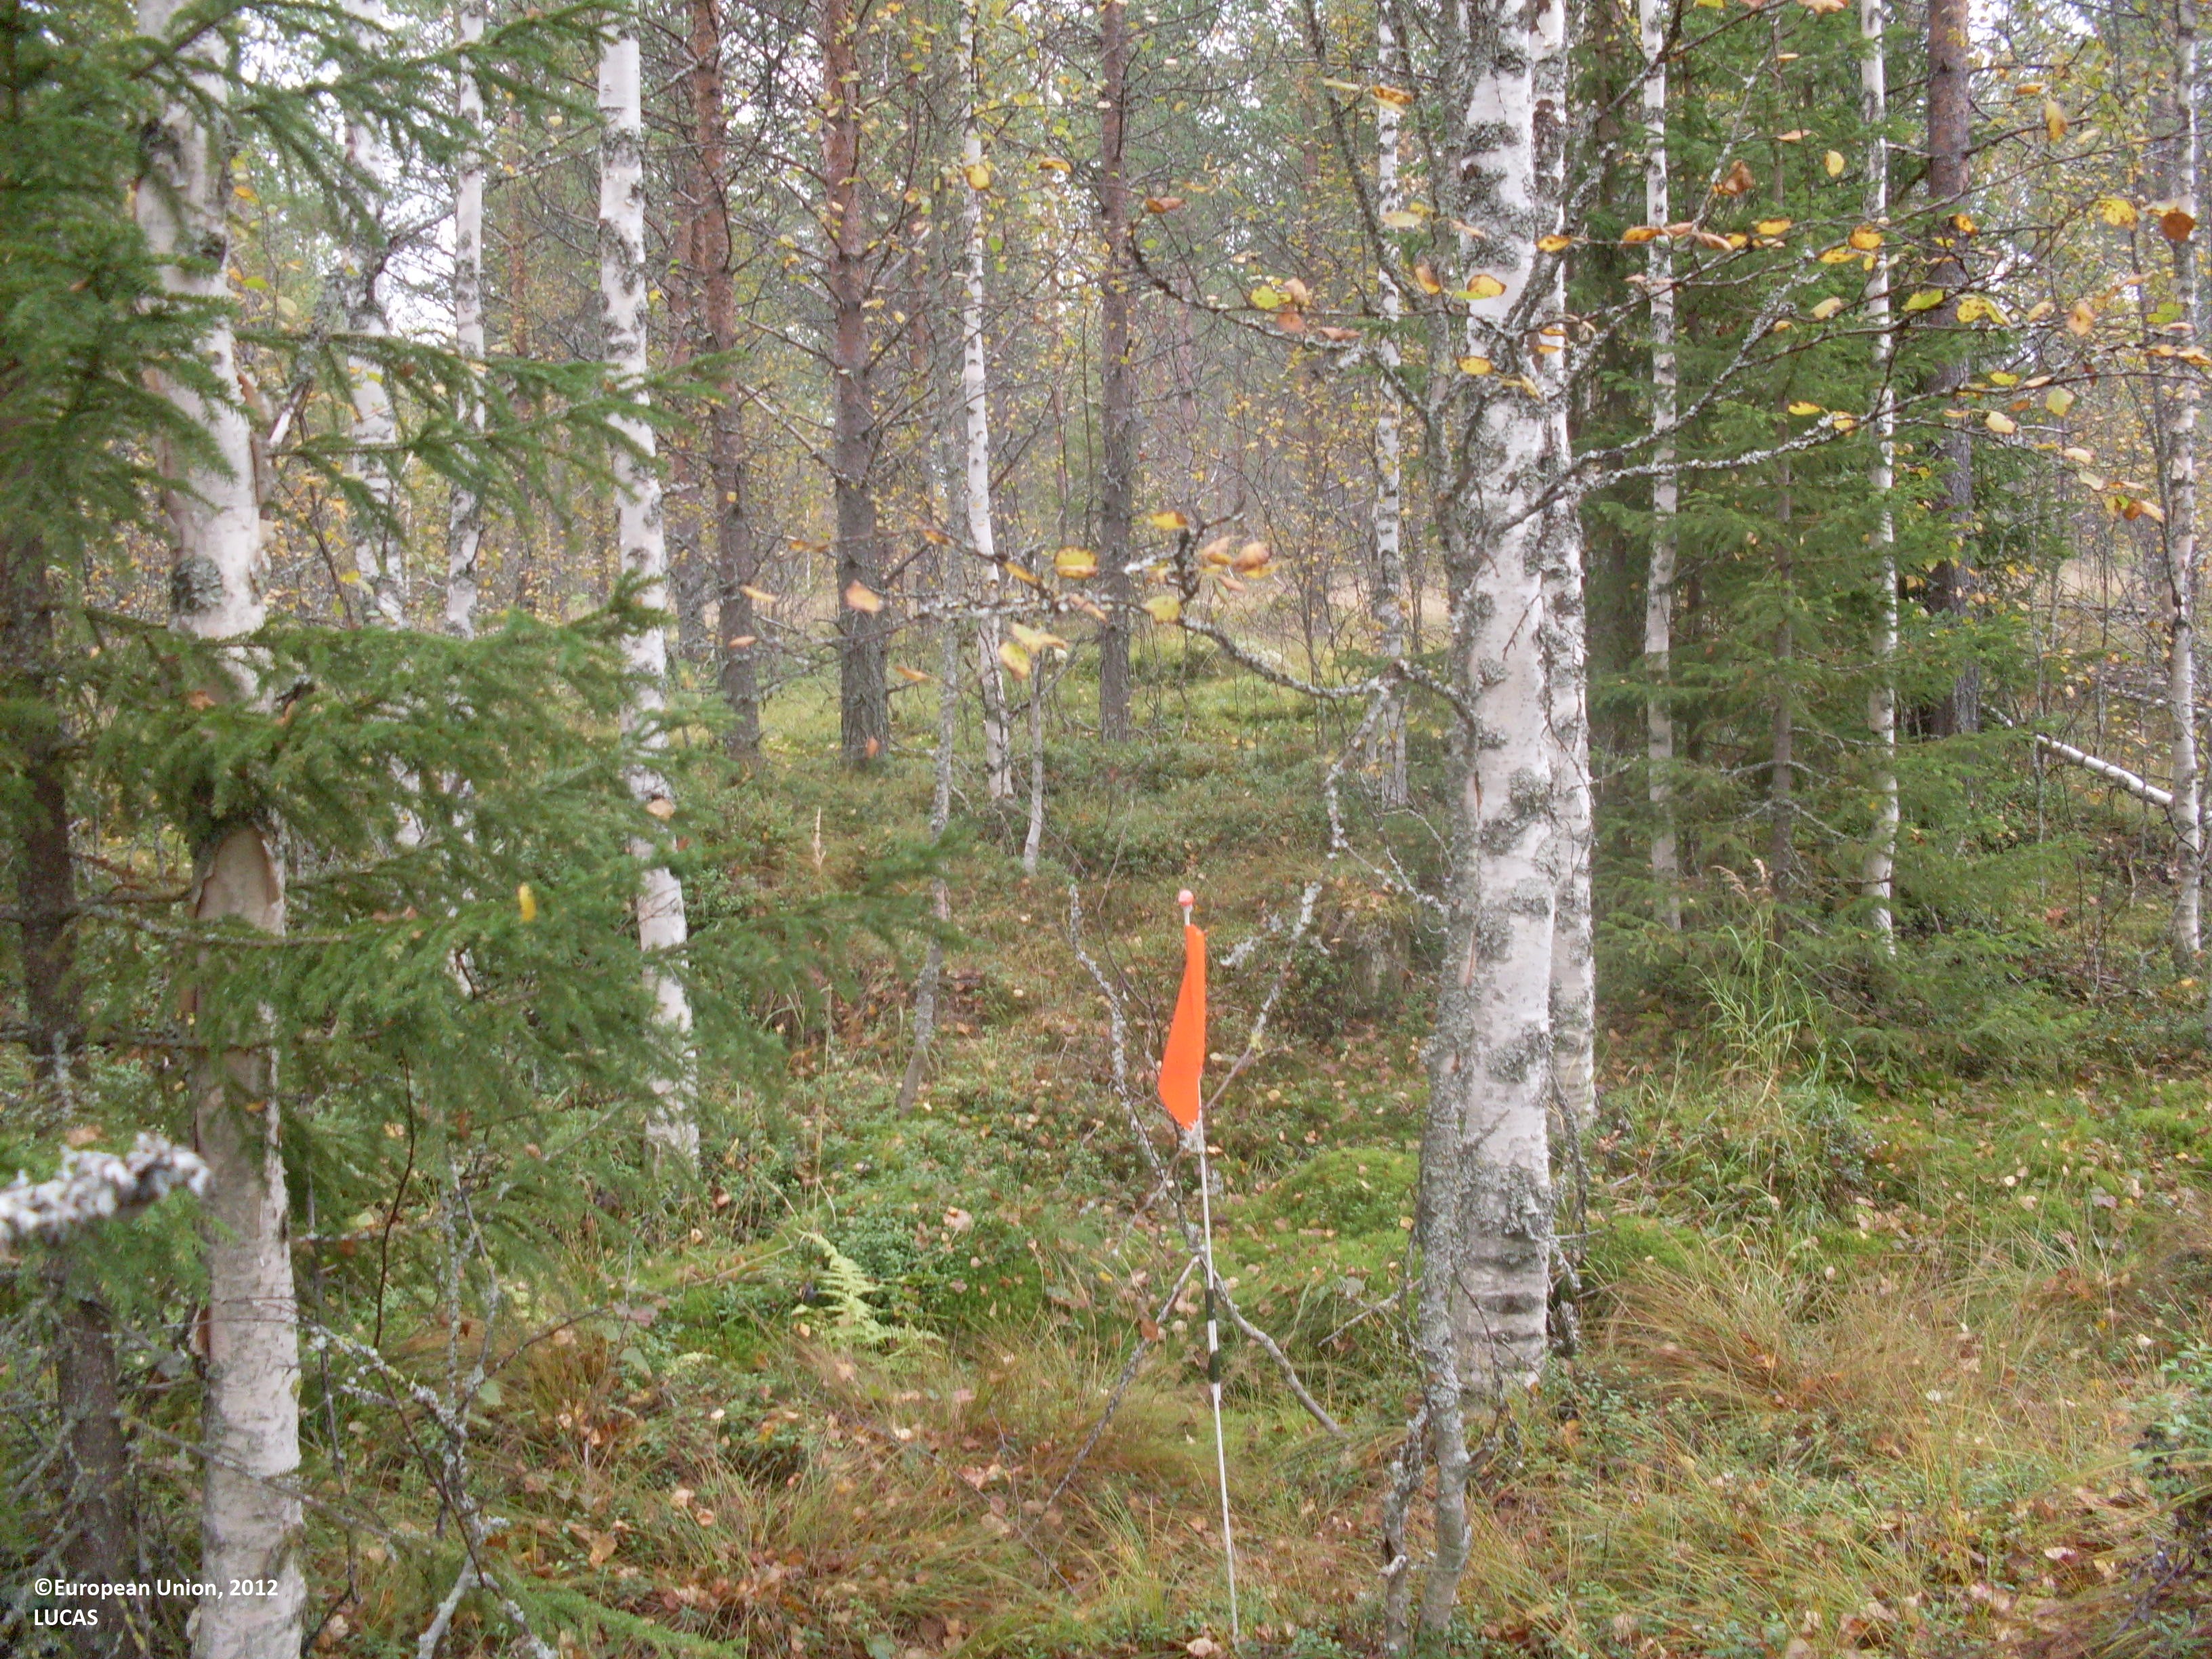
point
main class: Woodland
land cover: Other mixed woodland
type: boreal forest
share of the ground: > 75 %
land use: Forestry
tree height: > 5 m
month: September
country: FI
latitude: 63.9928
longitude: 29.4959
